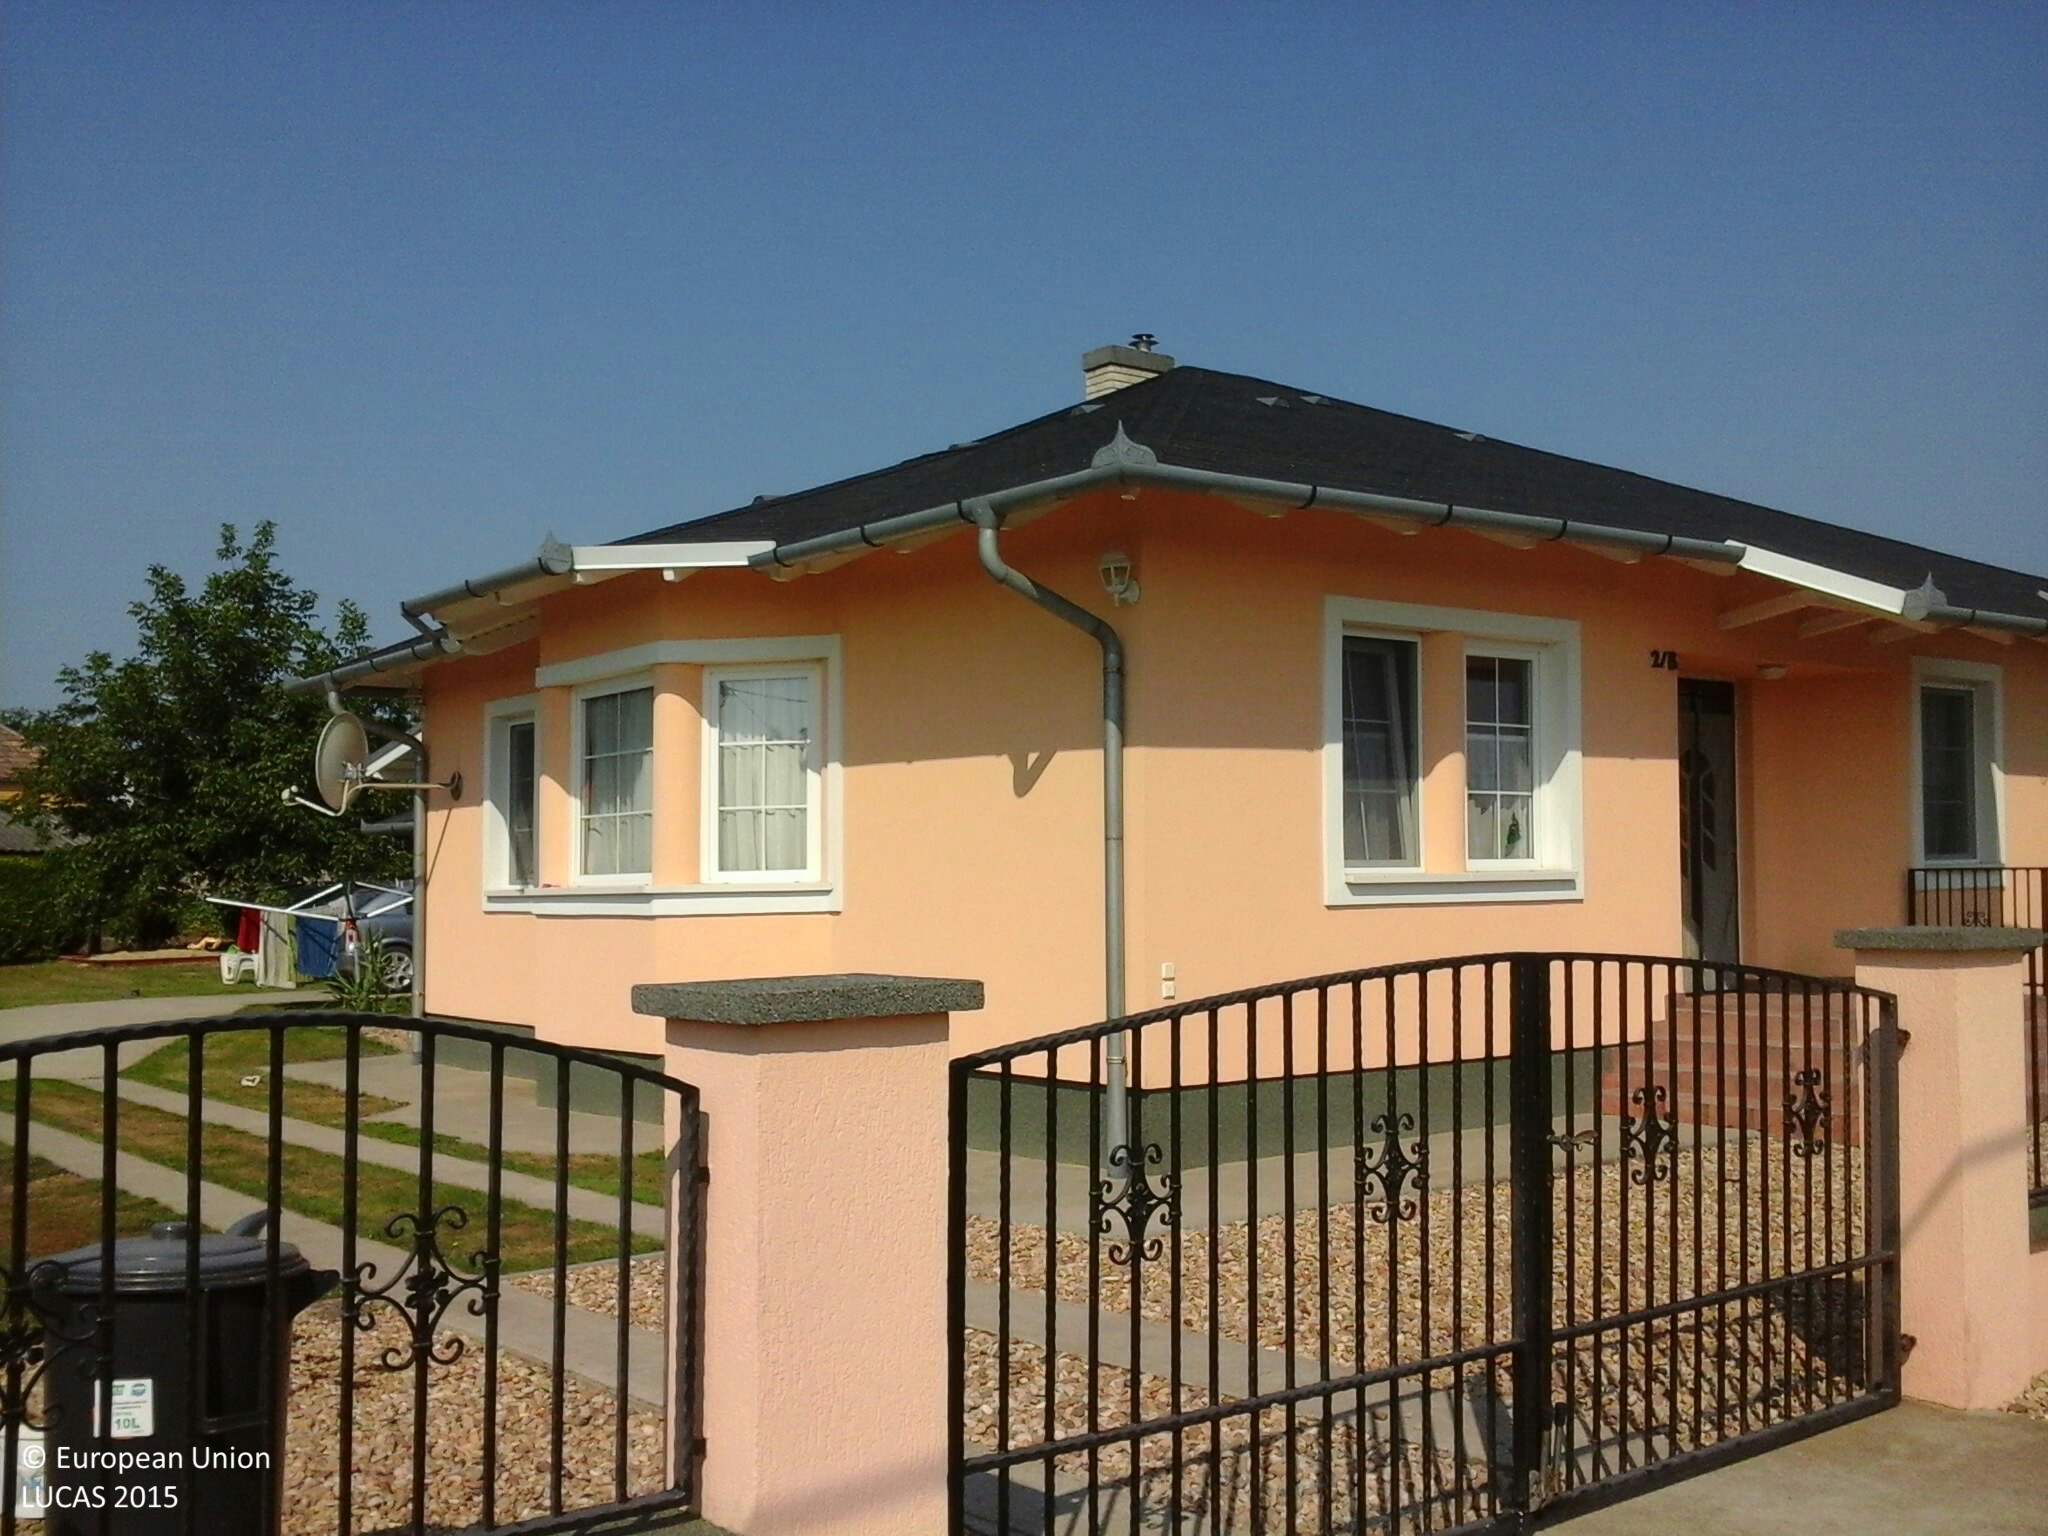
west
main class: Grassland
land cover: Grassland without tree/shrub cover
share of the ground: > 75 %
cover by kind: herbaceous plants 100 %
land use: Residential
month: August
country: HU
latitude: 46.9572
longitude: 18.2232
